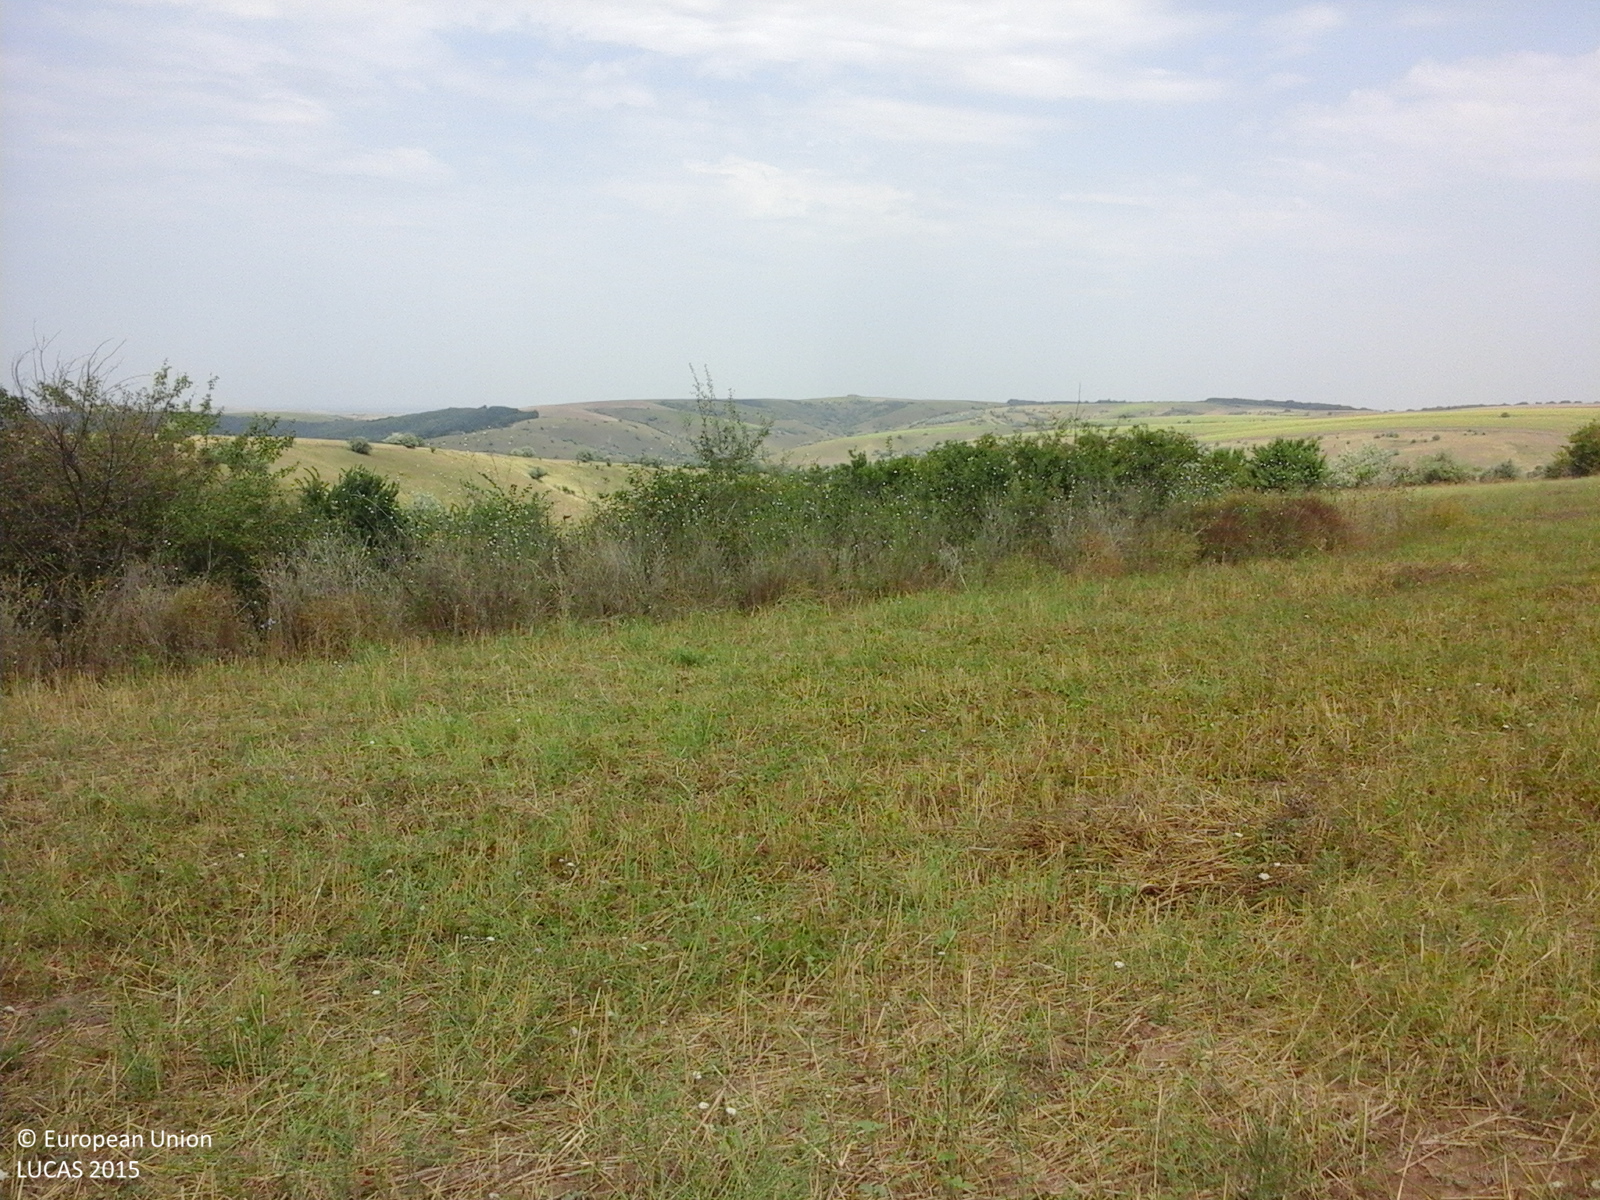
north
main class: Cropland
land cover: Common wheat
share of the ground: 10 - 25 %
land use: Agriculture (excluding fallow land and kitchen gardens)
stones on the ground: < 10 %
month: August
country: RO
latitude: 44.1623
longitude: 27.8953
